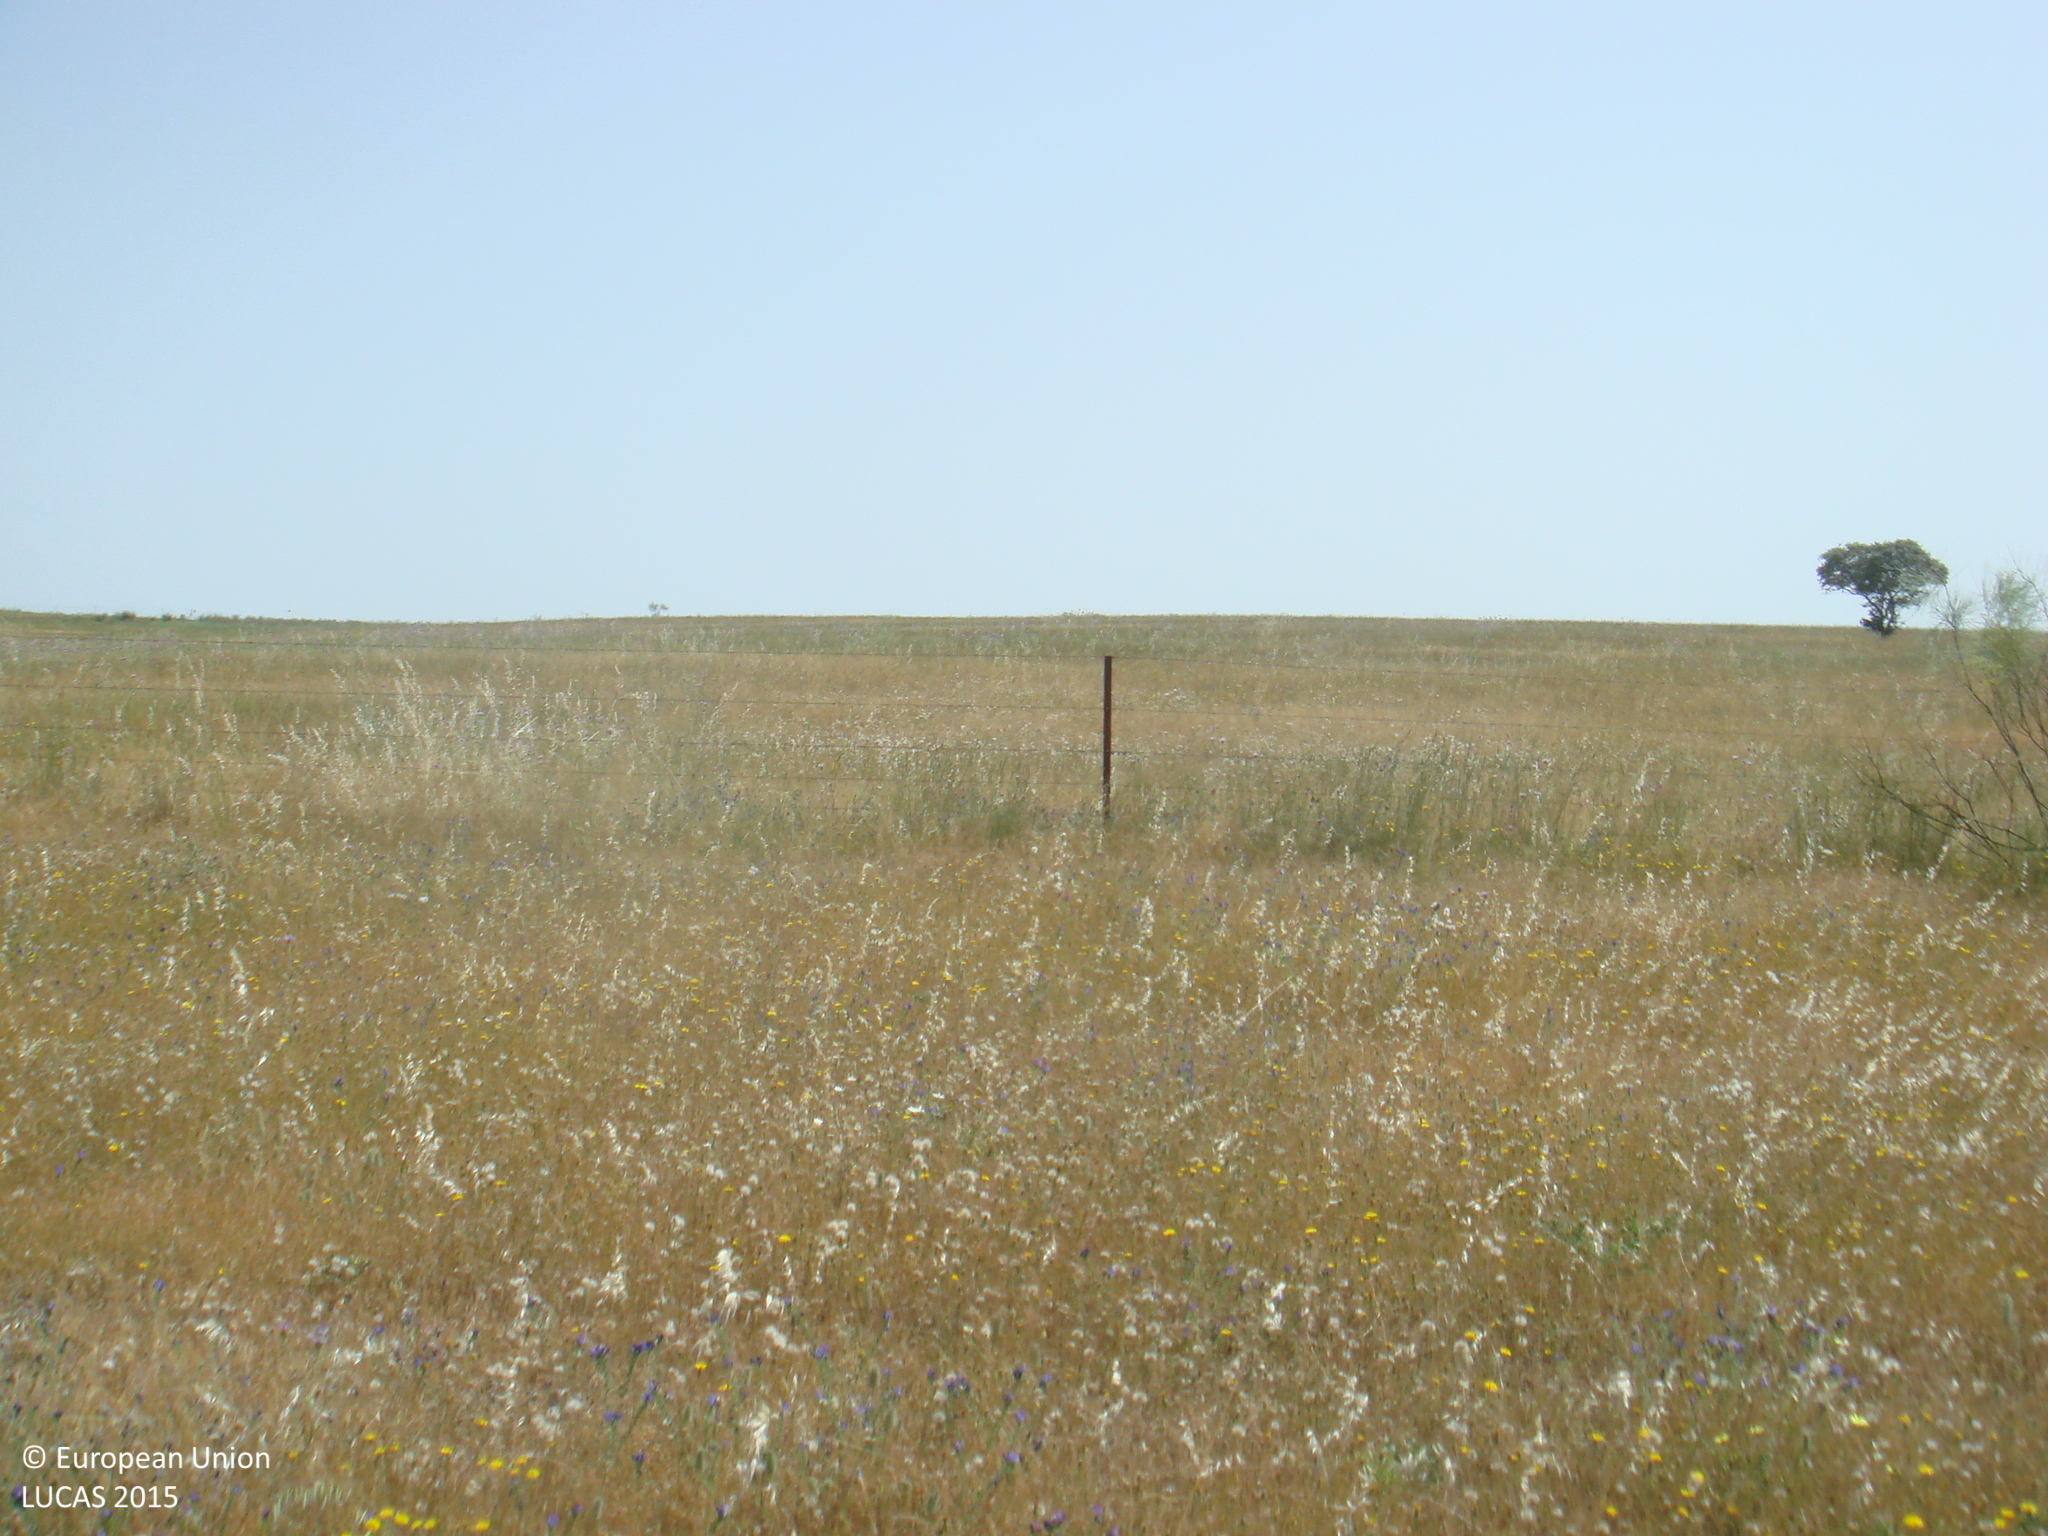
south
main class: Grassland
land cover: Grassland with sparse tree/shrub cover
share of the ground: > 75 %
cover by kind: herbaceous plants 95 %, broadleaved forest trees 5 %
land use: Agriculture (excluding fallow land and kitchen gardens)
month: May
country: ES
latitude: 38.5690
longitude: -4.7971
